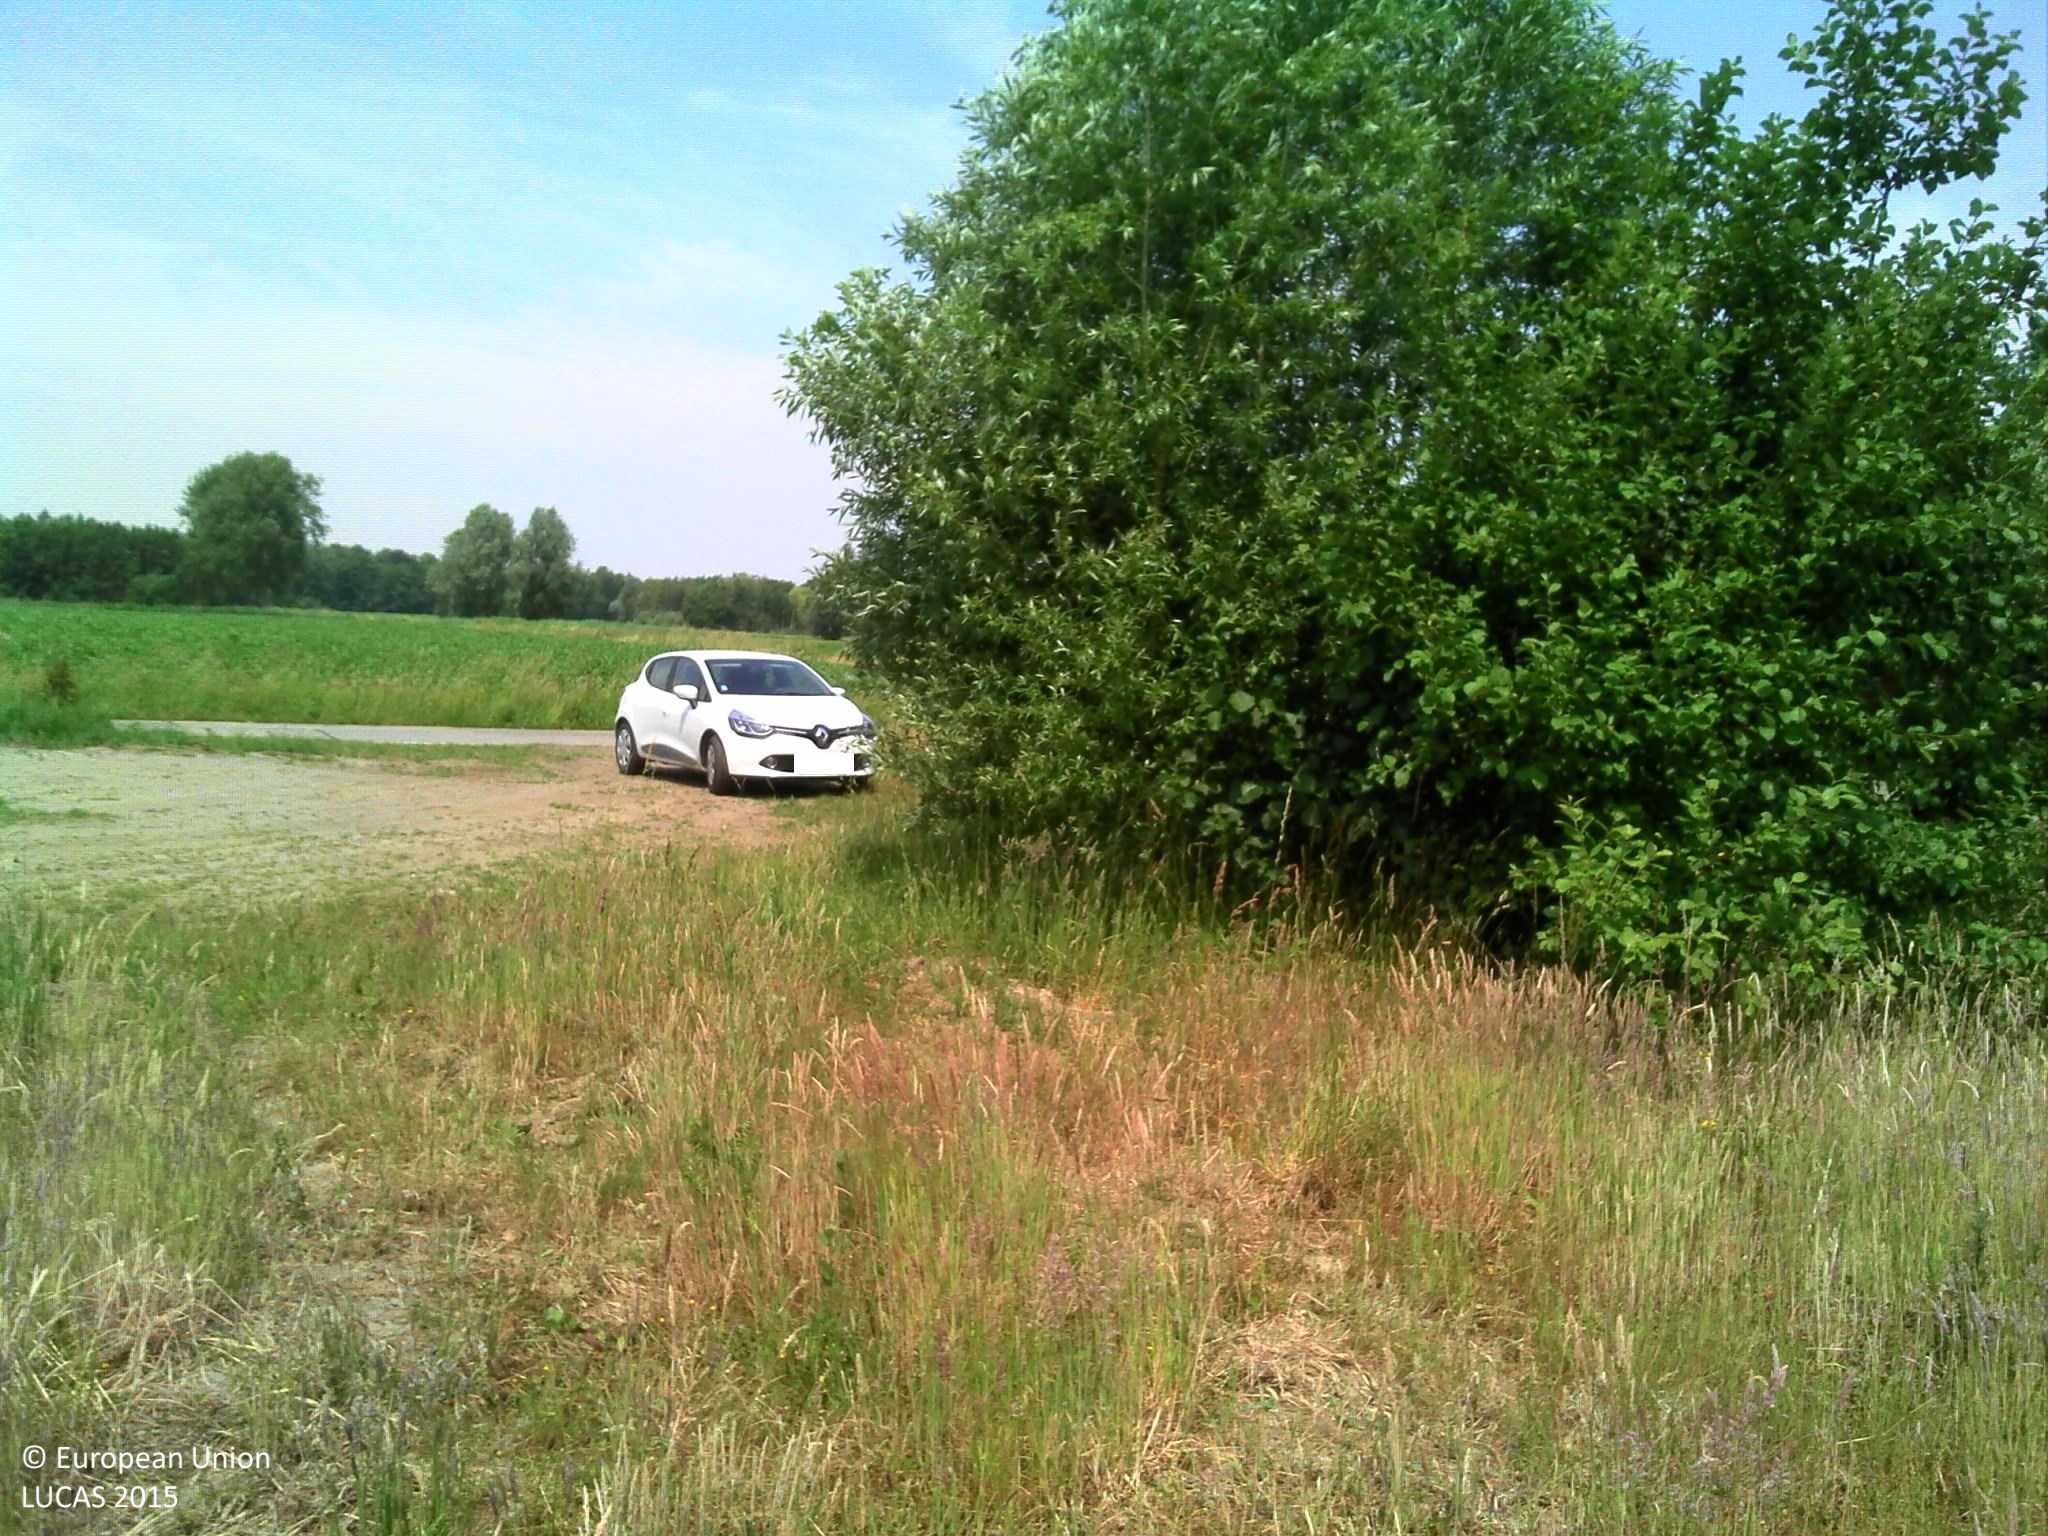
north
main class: Grassland
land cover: Grassland with sparse tree/shrub cover
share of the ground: > 75 %
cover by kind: herbaceous plants 95 %, broadleaved forest trees 5 %
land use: Agriculture (excluding fallow land and kitchen gardens)
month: June
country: BE
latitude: 51.2204
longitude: 4.0811
